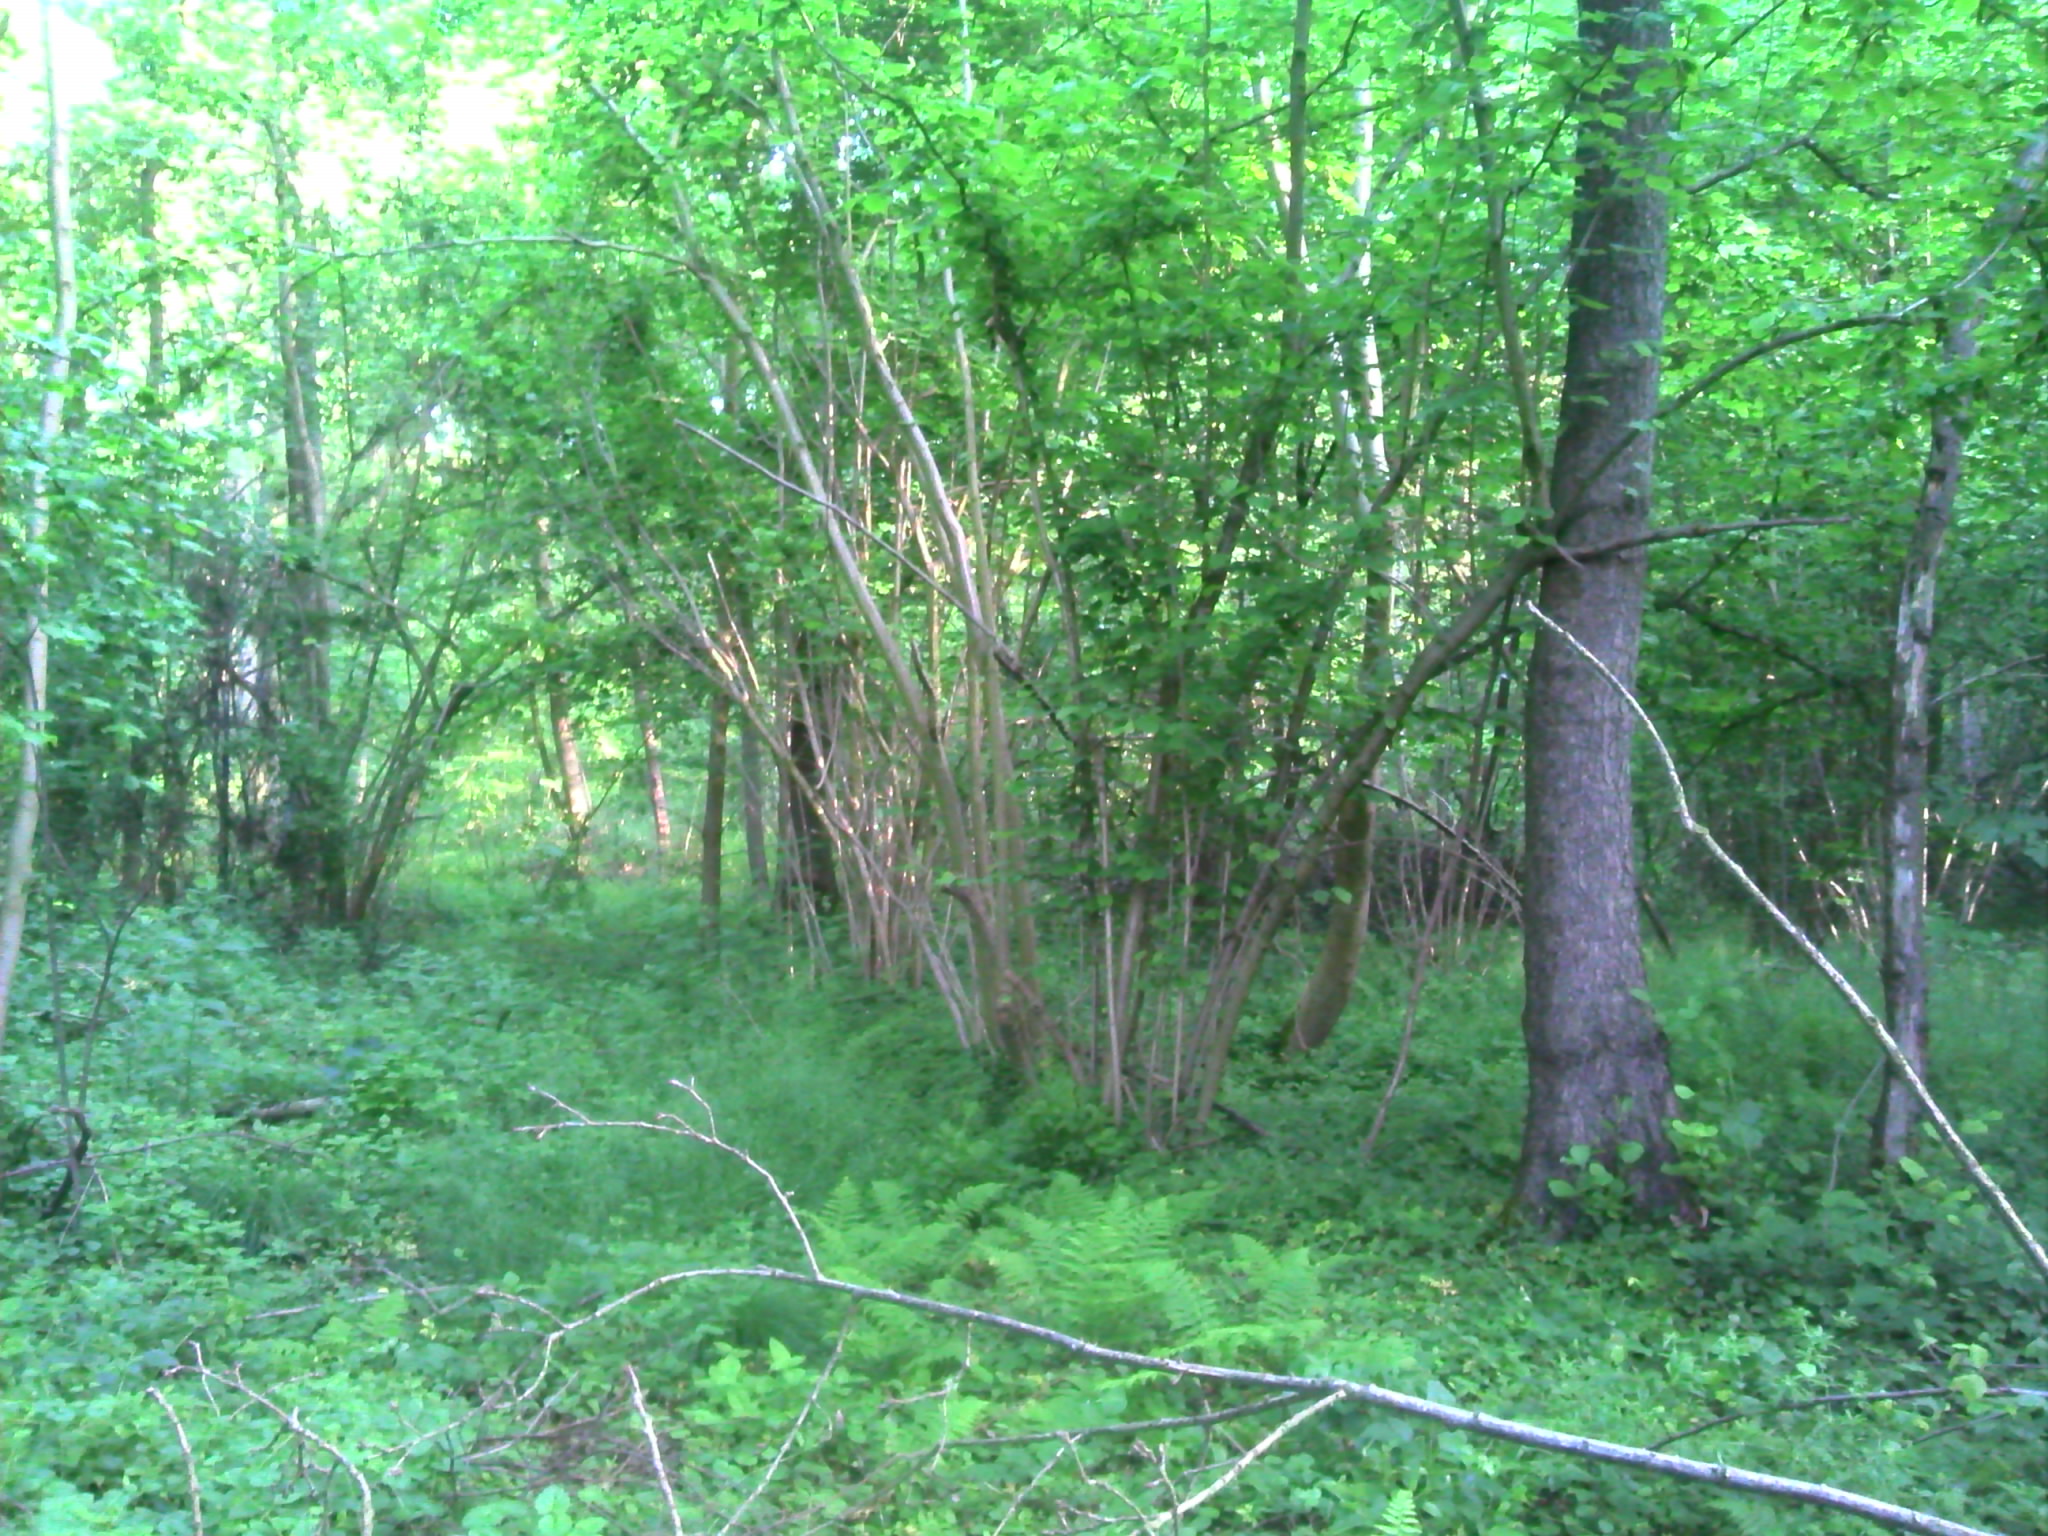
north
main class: Woodland
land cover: Broadleaved woodland
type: mesophytic deciduous forest
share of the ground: > 75 %
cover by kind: broadleaved forest trees 85 %, herbaceous plants 15 %
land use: Forestry
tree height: > 5 m
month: June
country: BE
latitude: 50.5875
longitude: 4.7847
